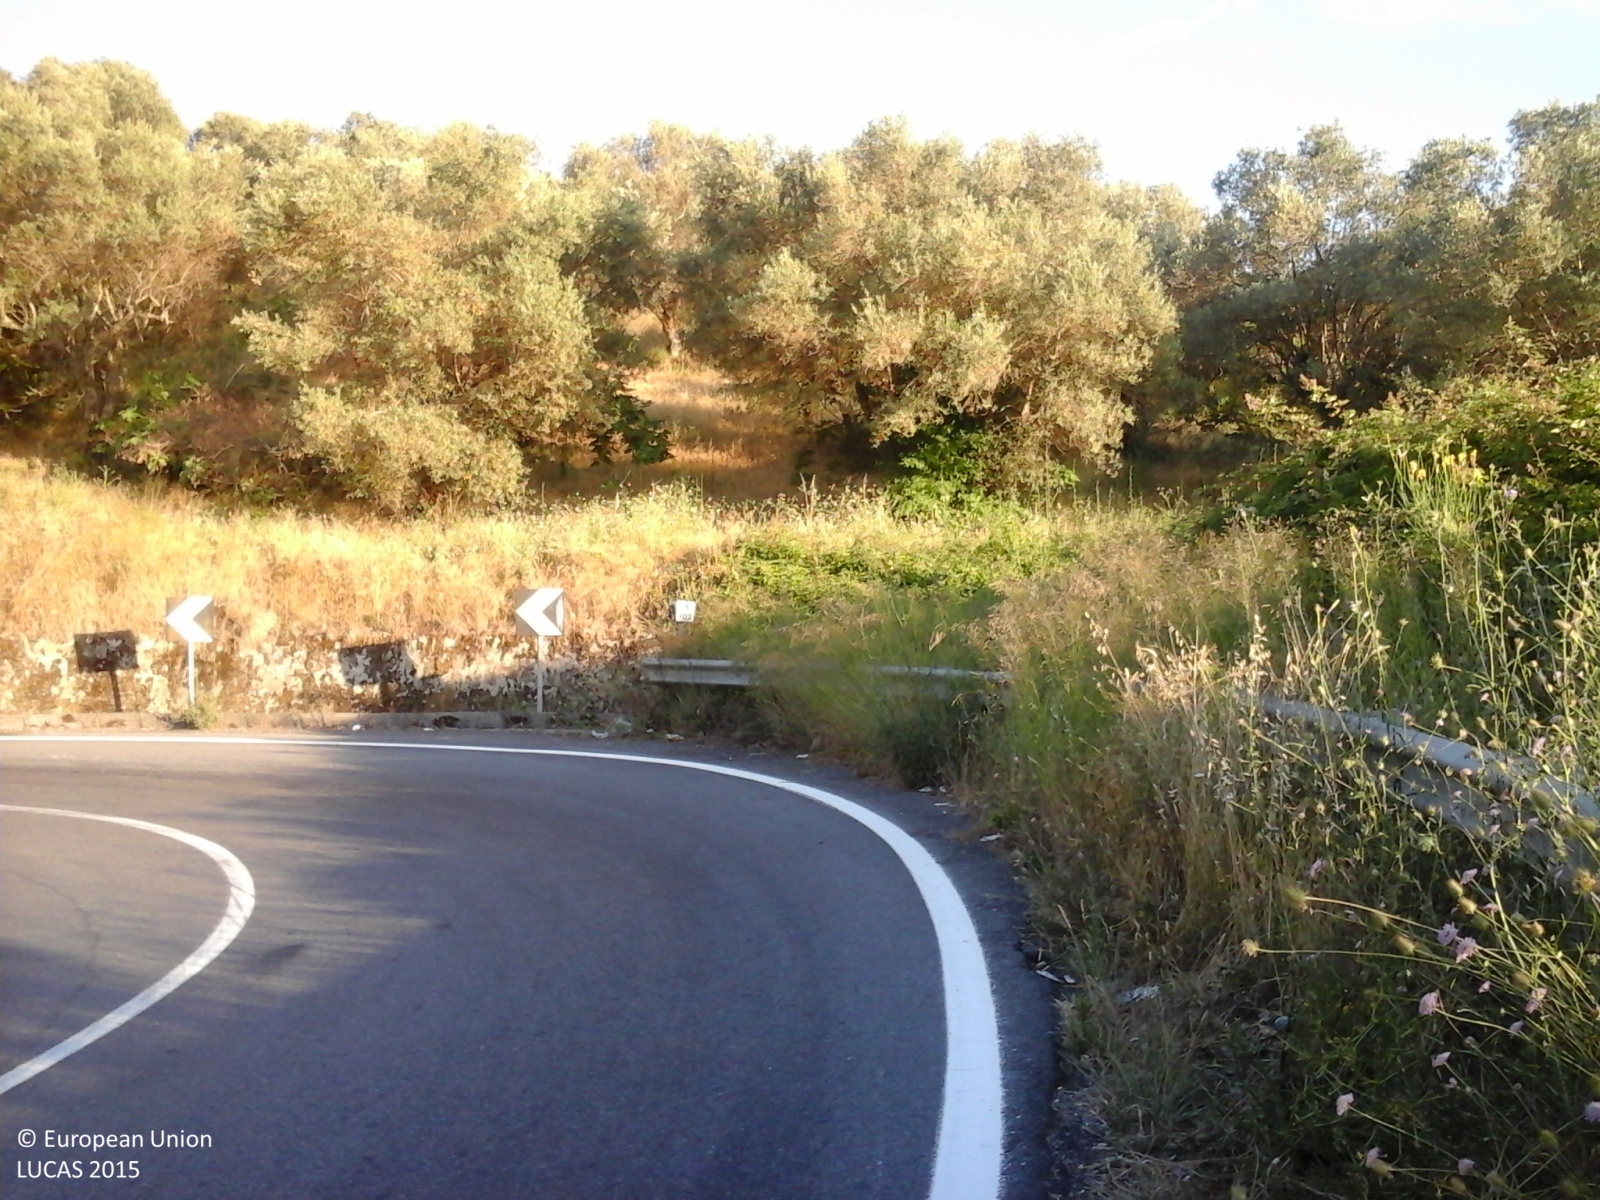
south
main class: Woodland
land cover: Broadleaved woodland
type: thermophilous deciduous forest
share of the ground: > 75 %
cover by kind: broadleaved forest trees 100 %
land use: Forestry
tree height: > 5 m
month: June
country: IT
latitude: 40.3739
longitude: 15.0307
